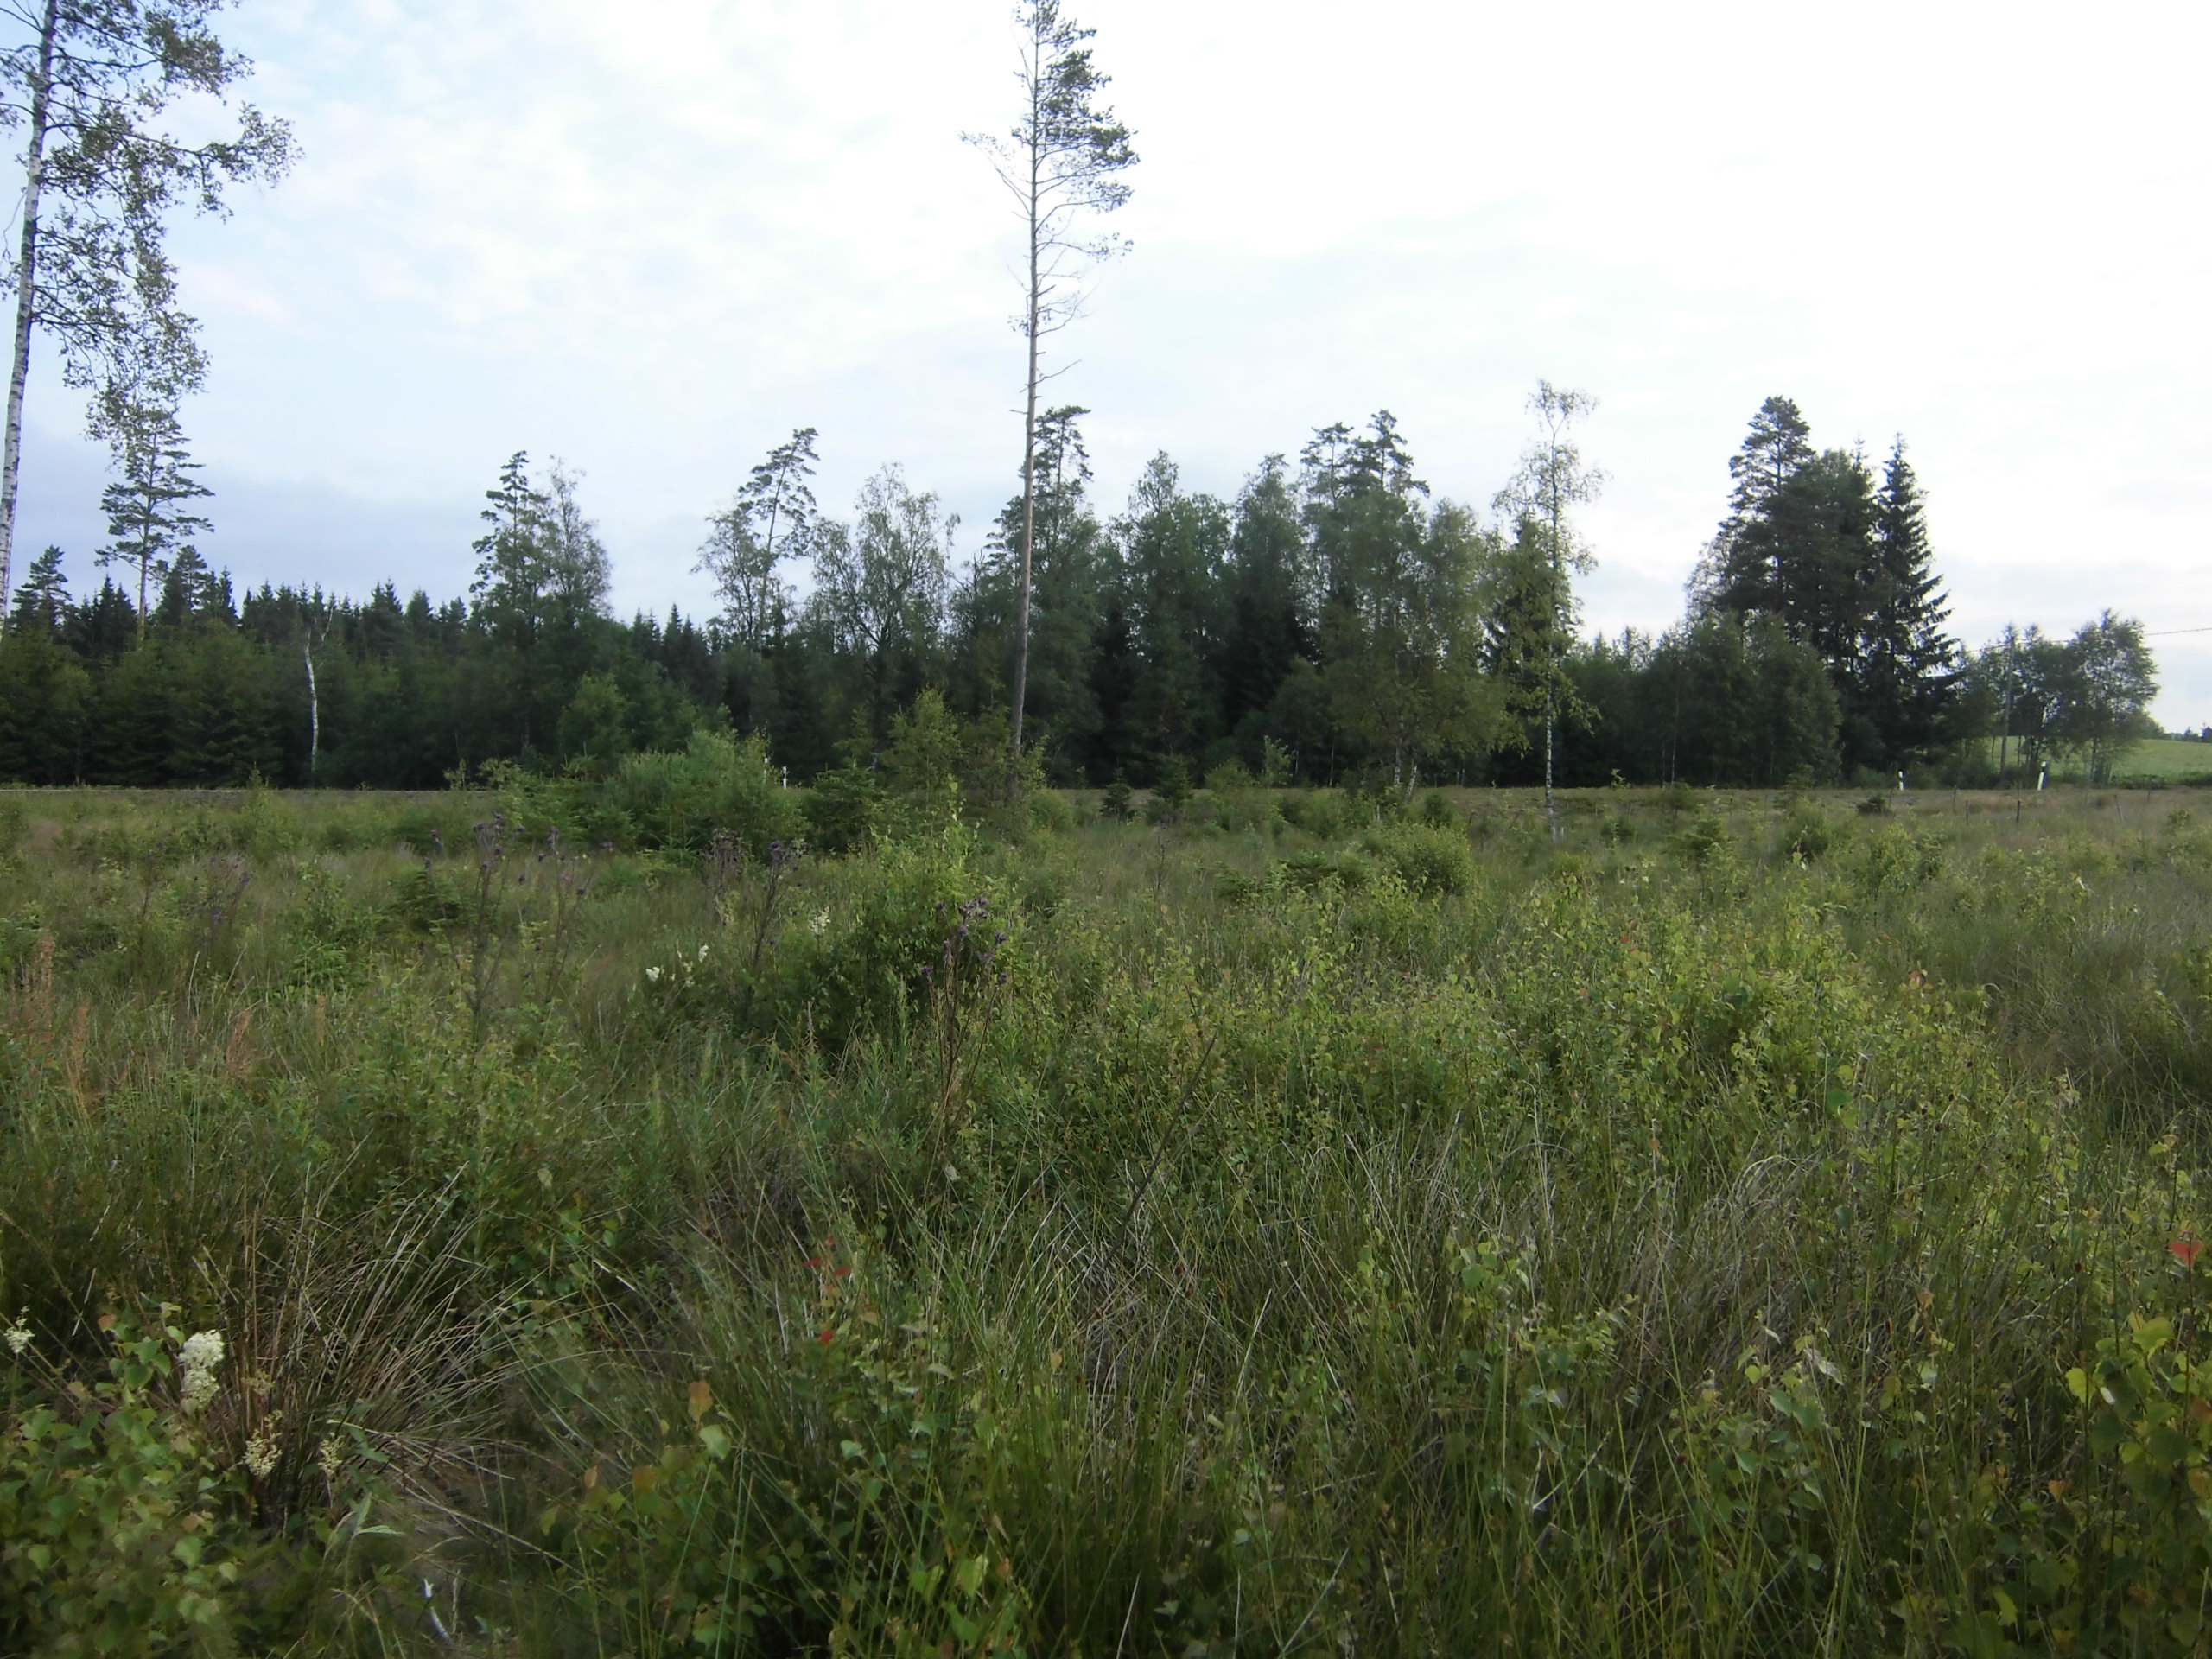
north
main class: Woodland
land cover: Pine dominated mixed woodland
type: boreal forest
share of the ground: 25 - 50 %
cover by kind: herbaceous plants 40 %, shrubs 25 %, broadleaved forest trees 15 %, coniferous forest trees 10 %, lichens and mosses 10 %
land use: Forestry
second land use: Amenities, museums, leisure
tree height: > 5 m
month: July
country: SE
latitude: 57.3937
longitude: 14.8380
